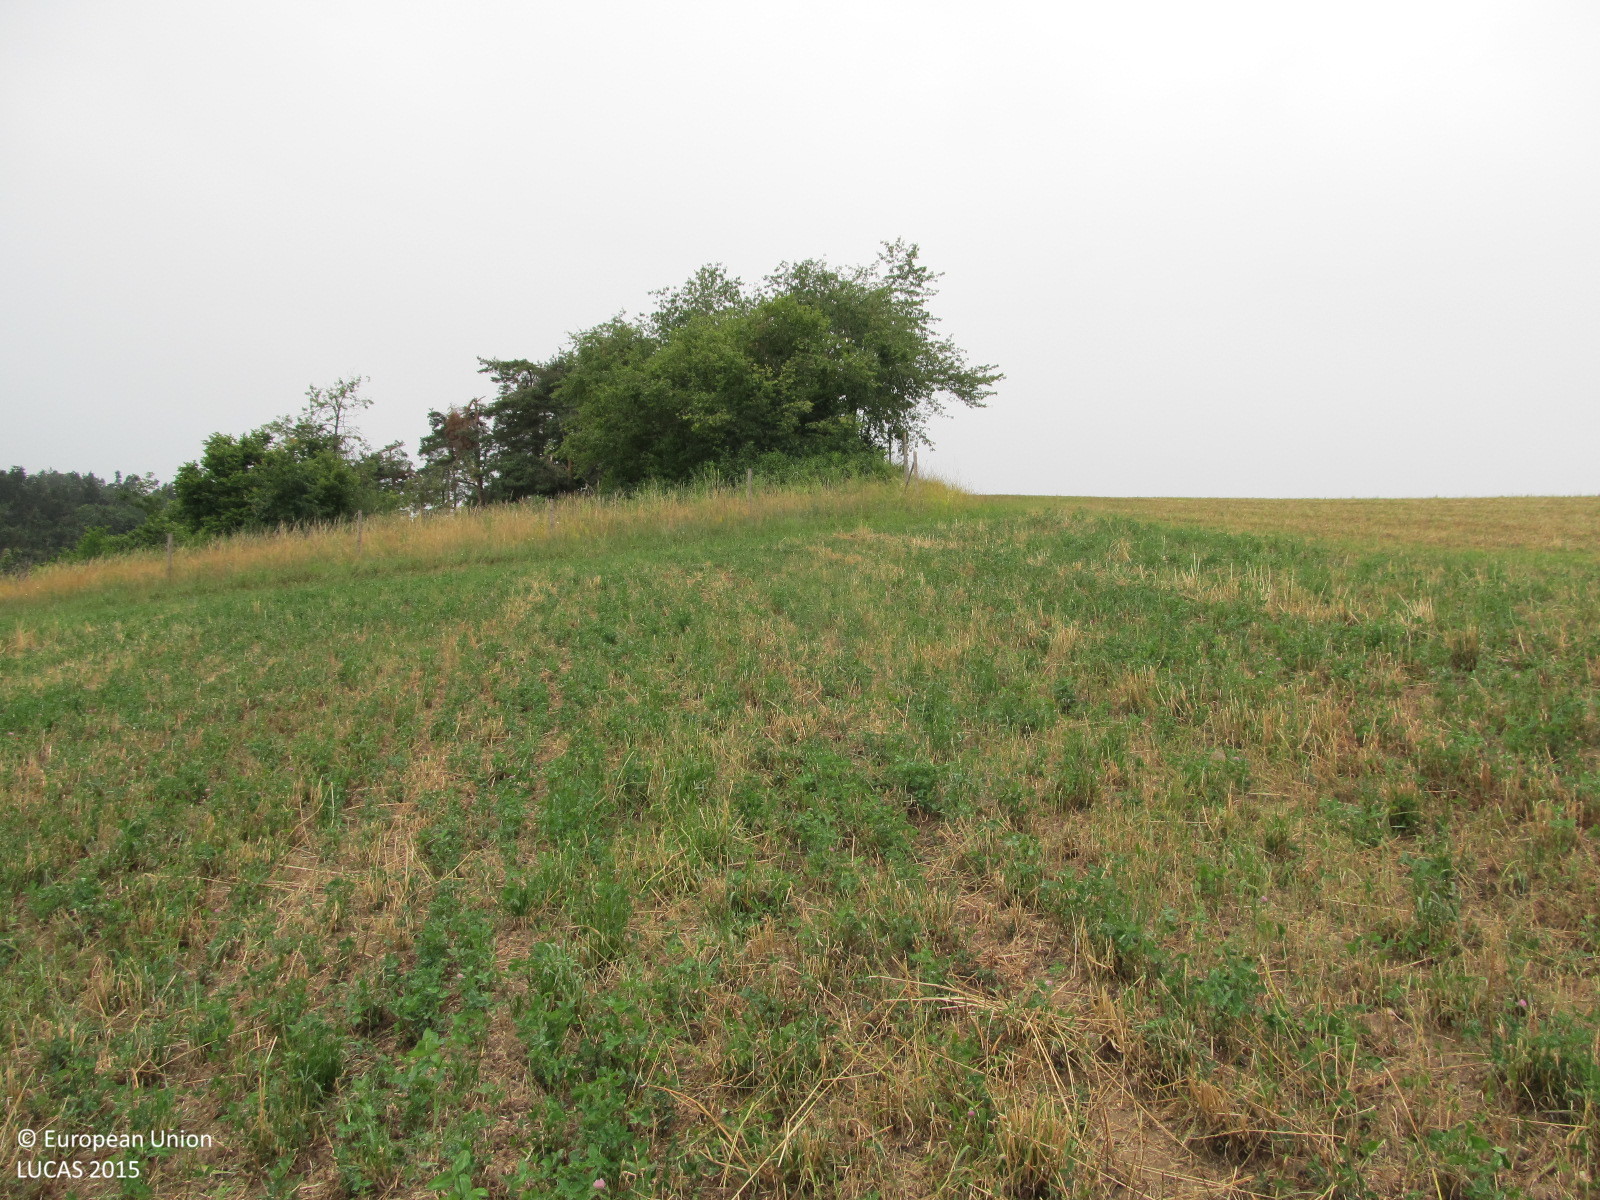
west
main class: Cropland
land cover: Temporary grasslands
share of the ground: > 75 %
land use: Agriculture (excluding fallow land and kitchen gardens)
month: July
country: AT
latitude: 48.4494
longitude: 15.4512
